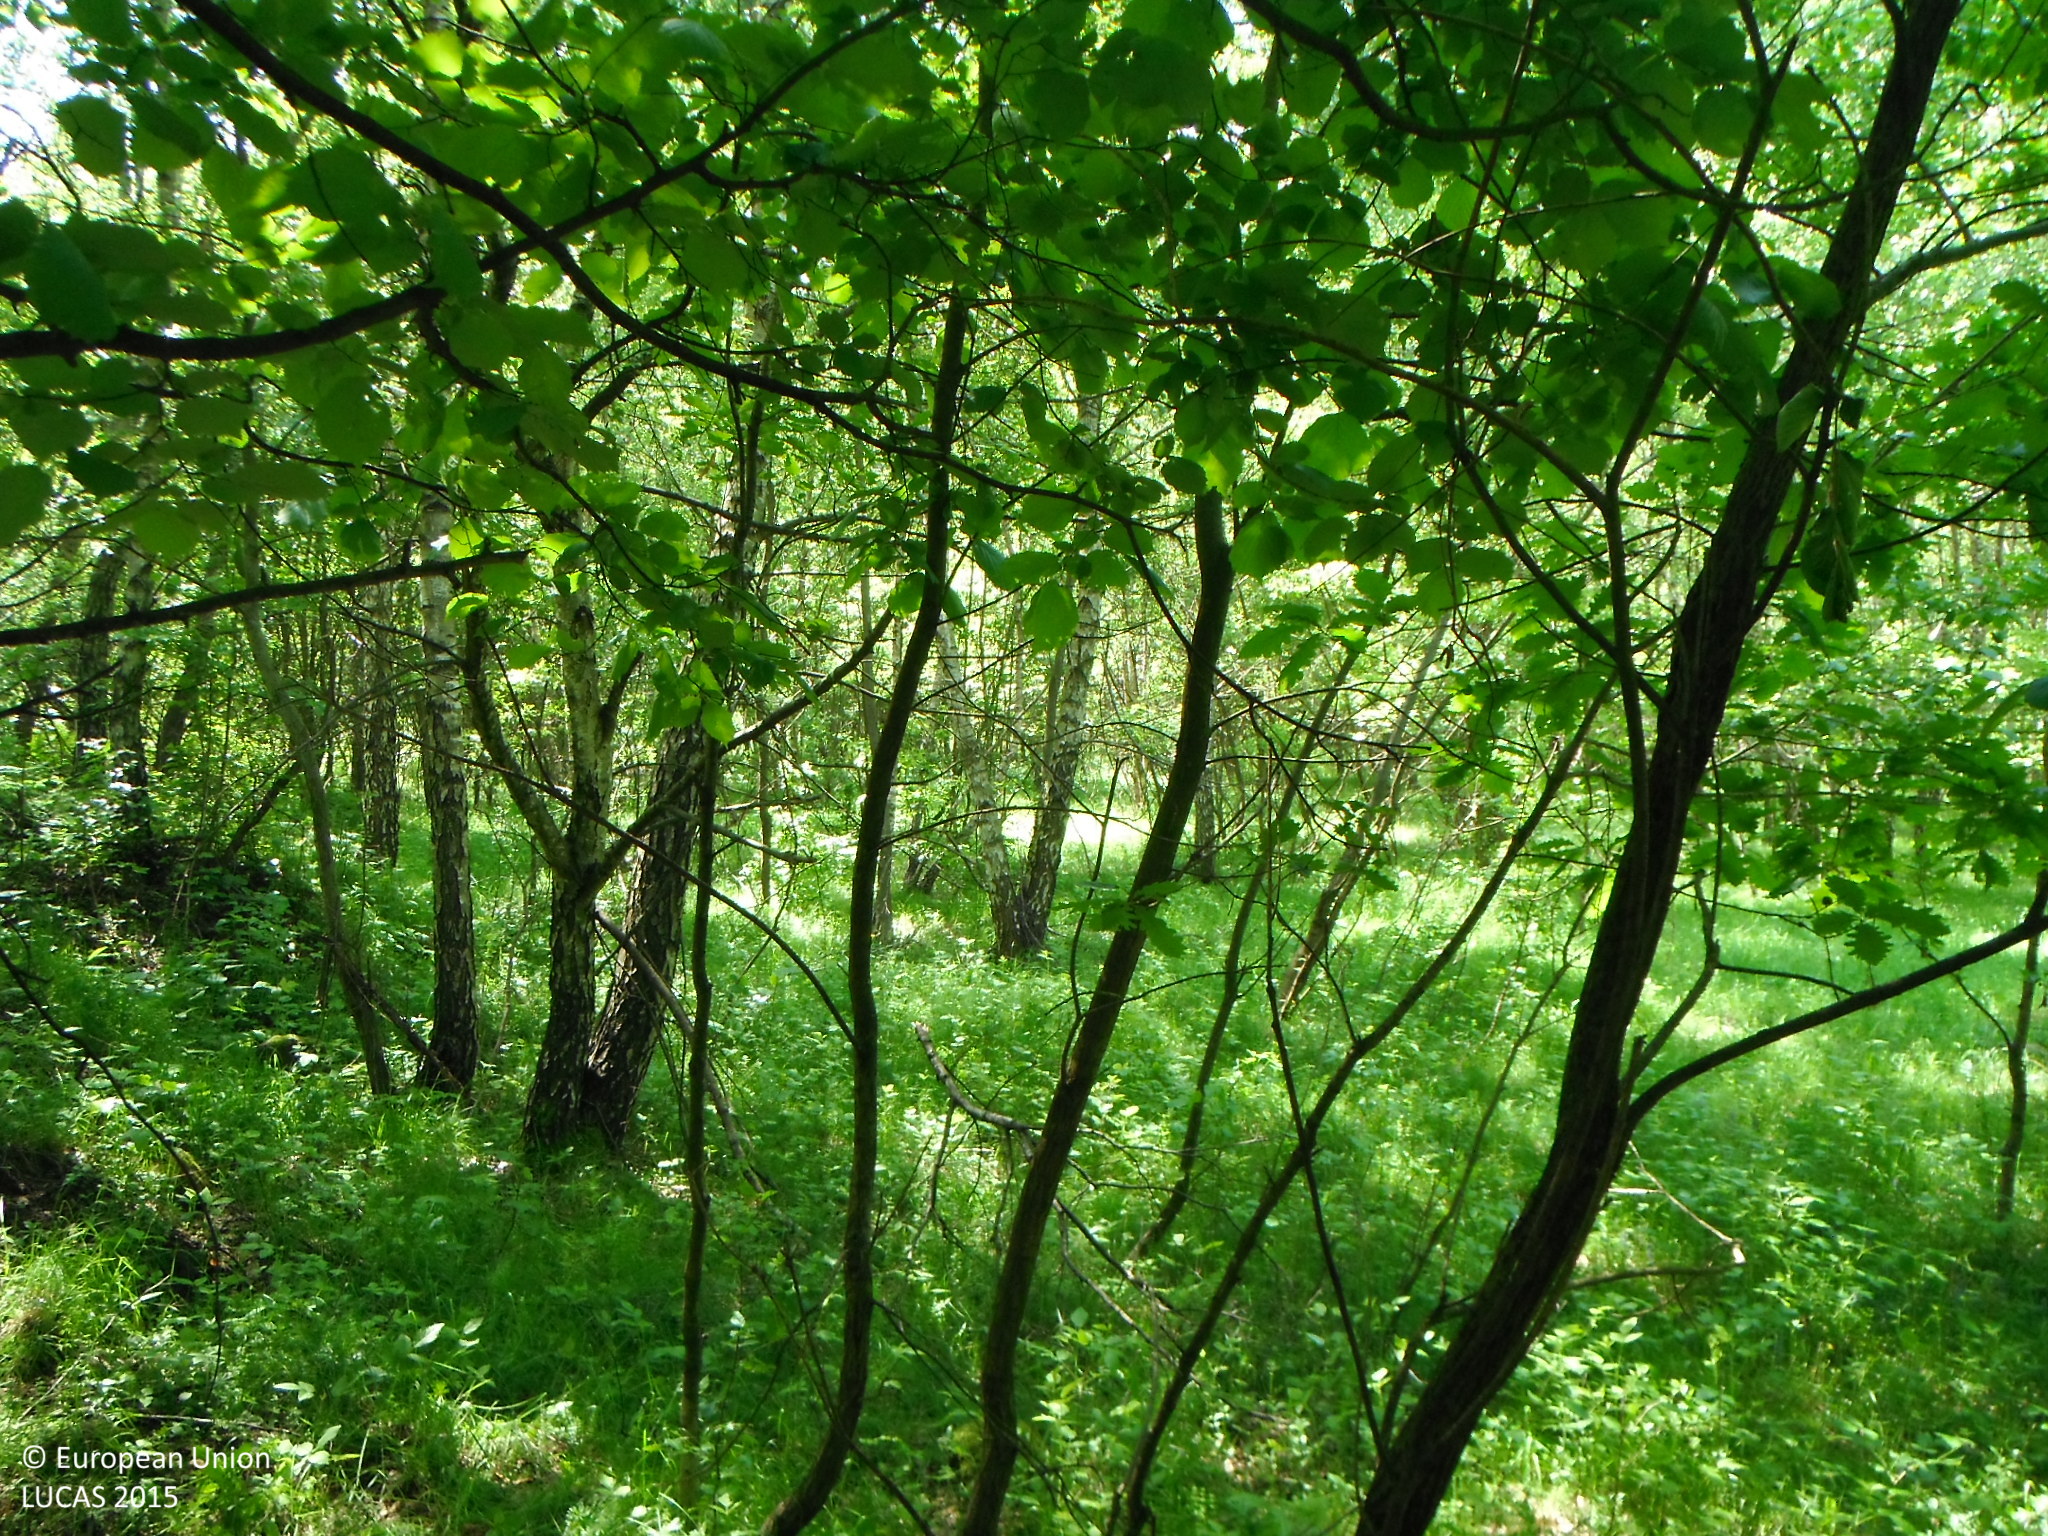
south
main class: Woodland
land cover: Broadleaved woodland
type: acidophilous oak and oak-birch forest
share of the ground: > 75 %
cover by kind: broadleaved forest trees 100 %
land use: Forestry
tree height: > 5 m
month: May
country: SK
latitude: 48.4334
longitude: 19.0086
